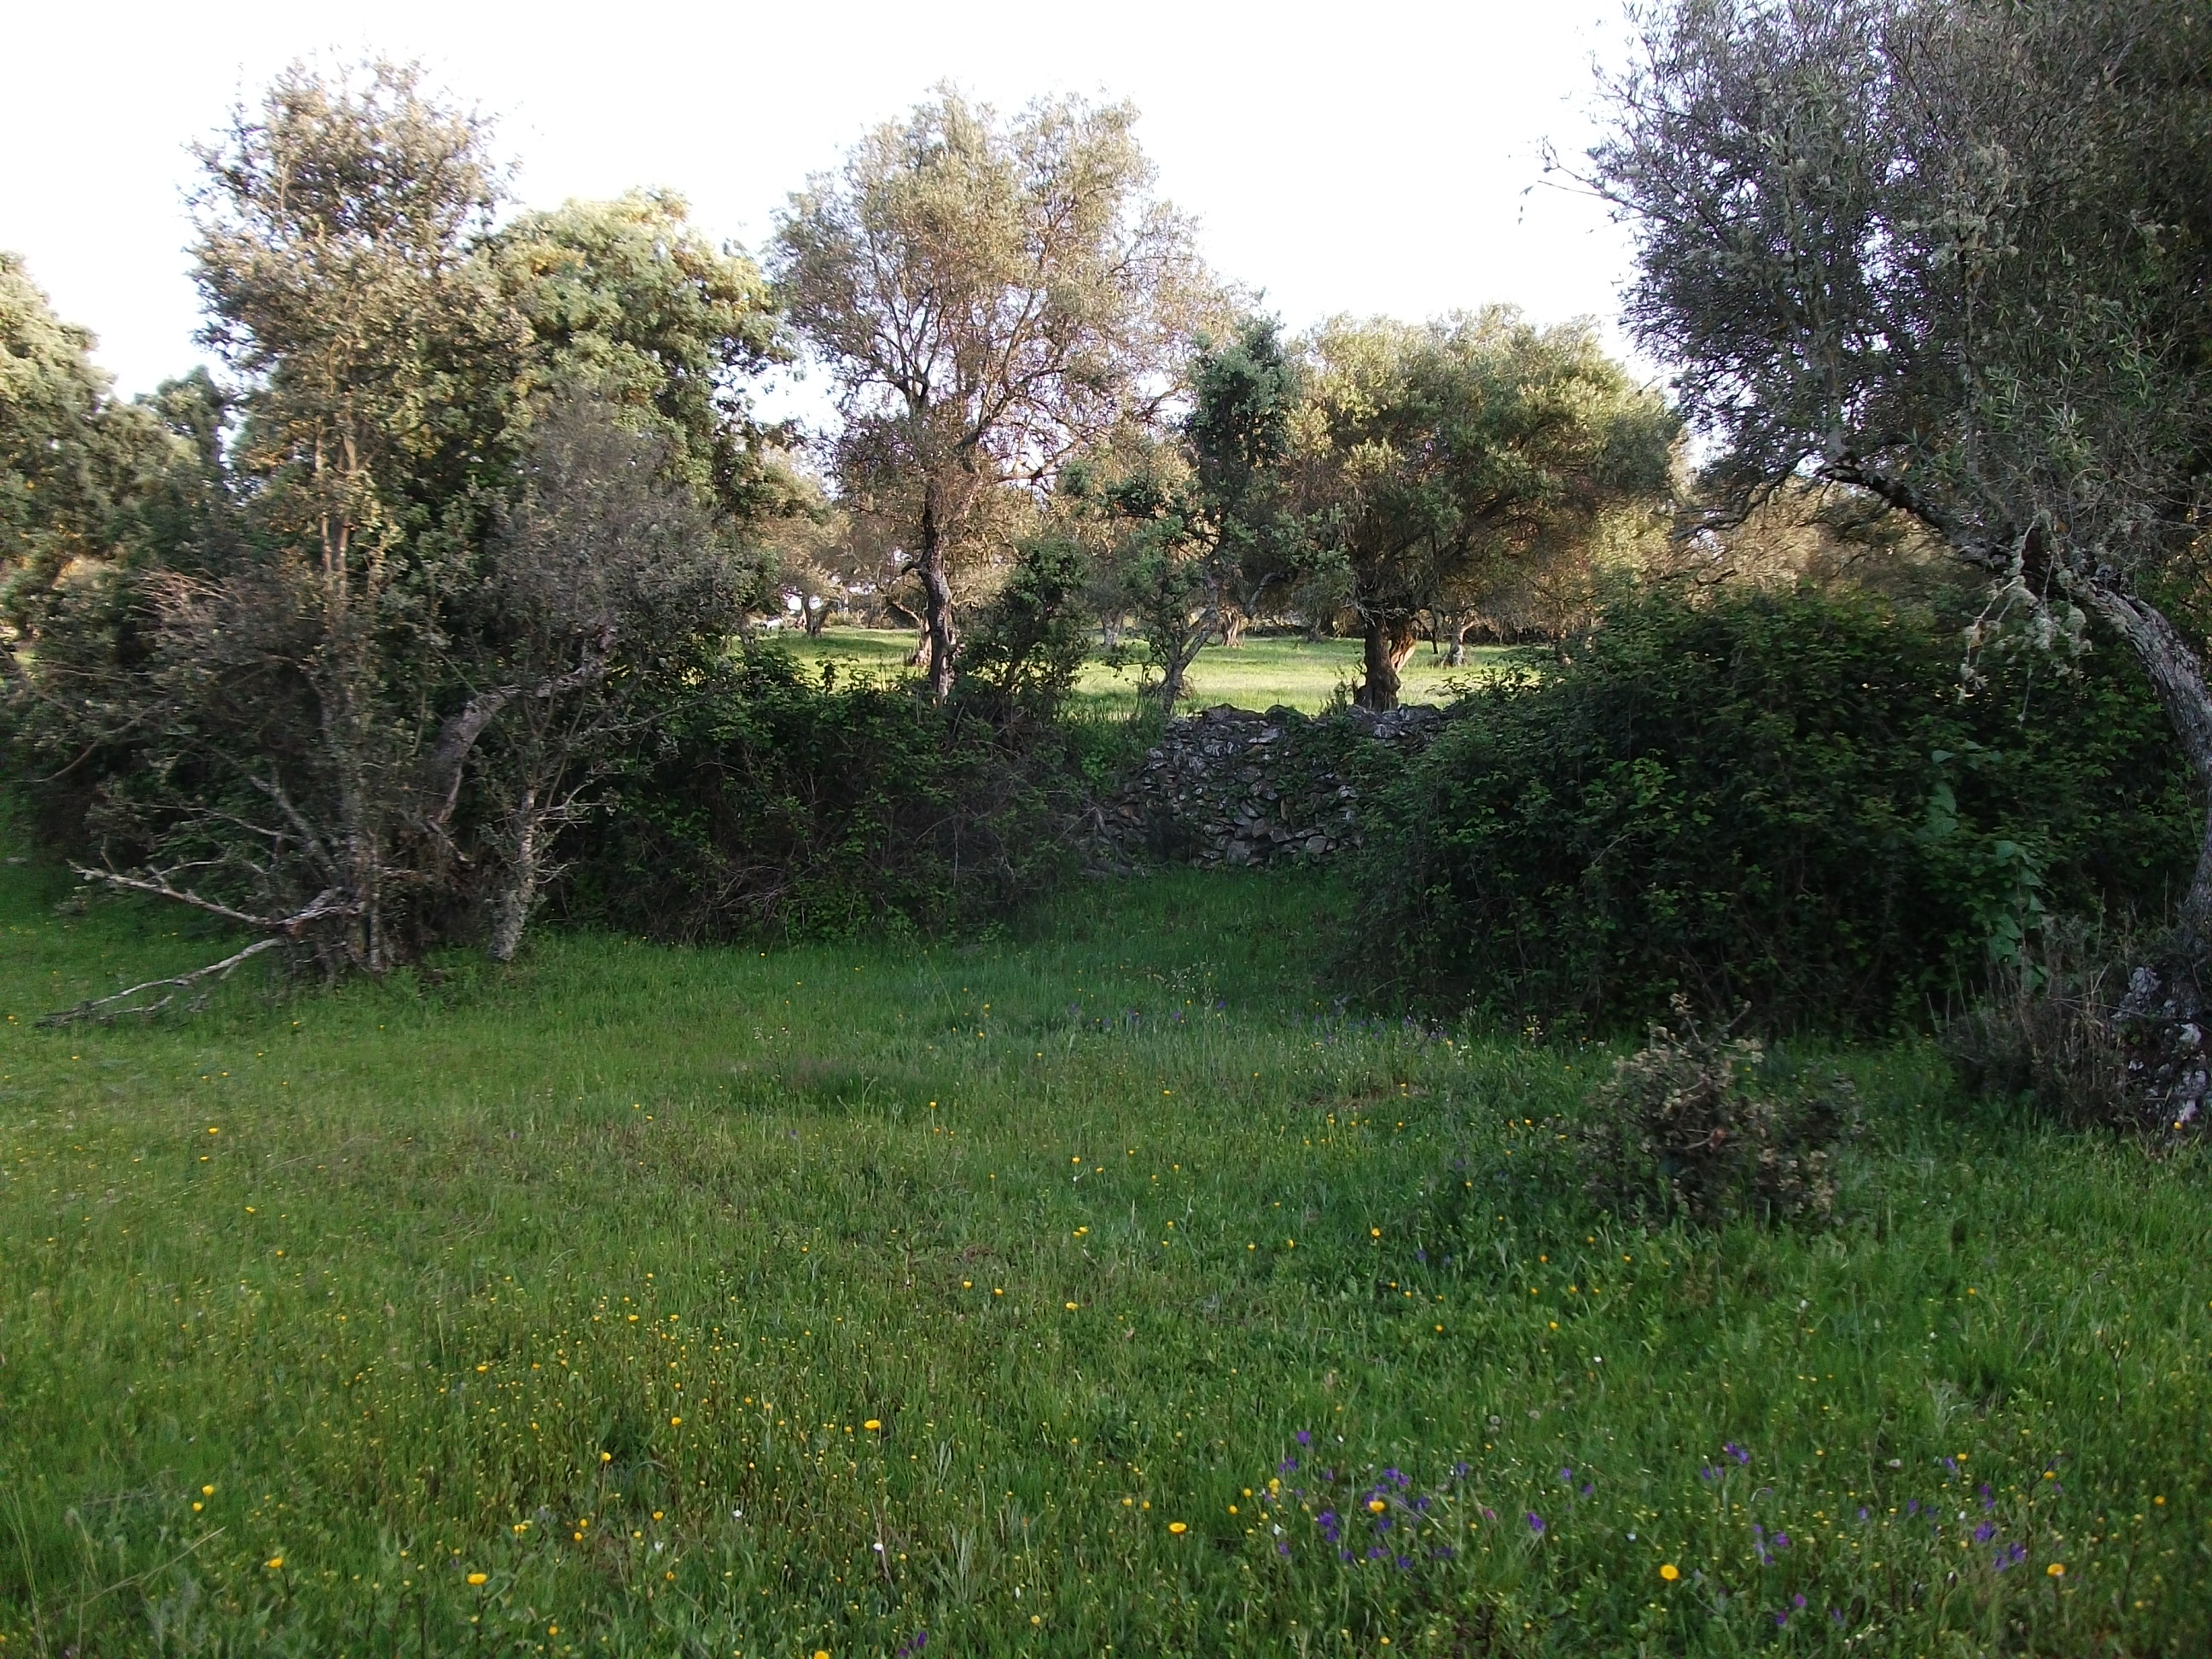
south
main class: Cropland
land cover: Olive groves
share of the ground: 25 - 50 %
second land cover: Spontaneously vegetated surfaces
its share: > 75 %
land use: Agriculture (excluding fallow land and kitchen gardens)
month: April
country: ES
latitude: 38.0798
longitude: -6.6358
